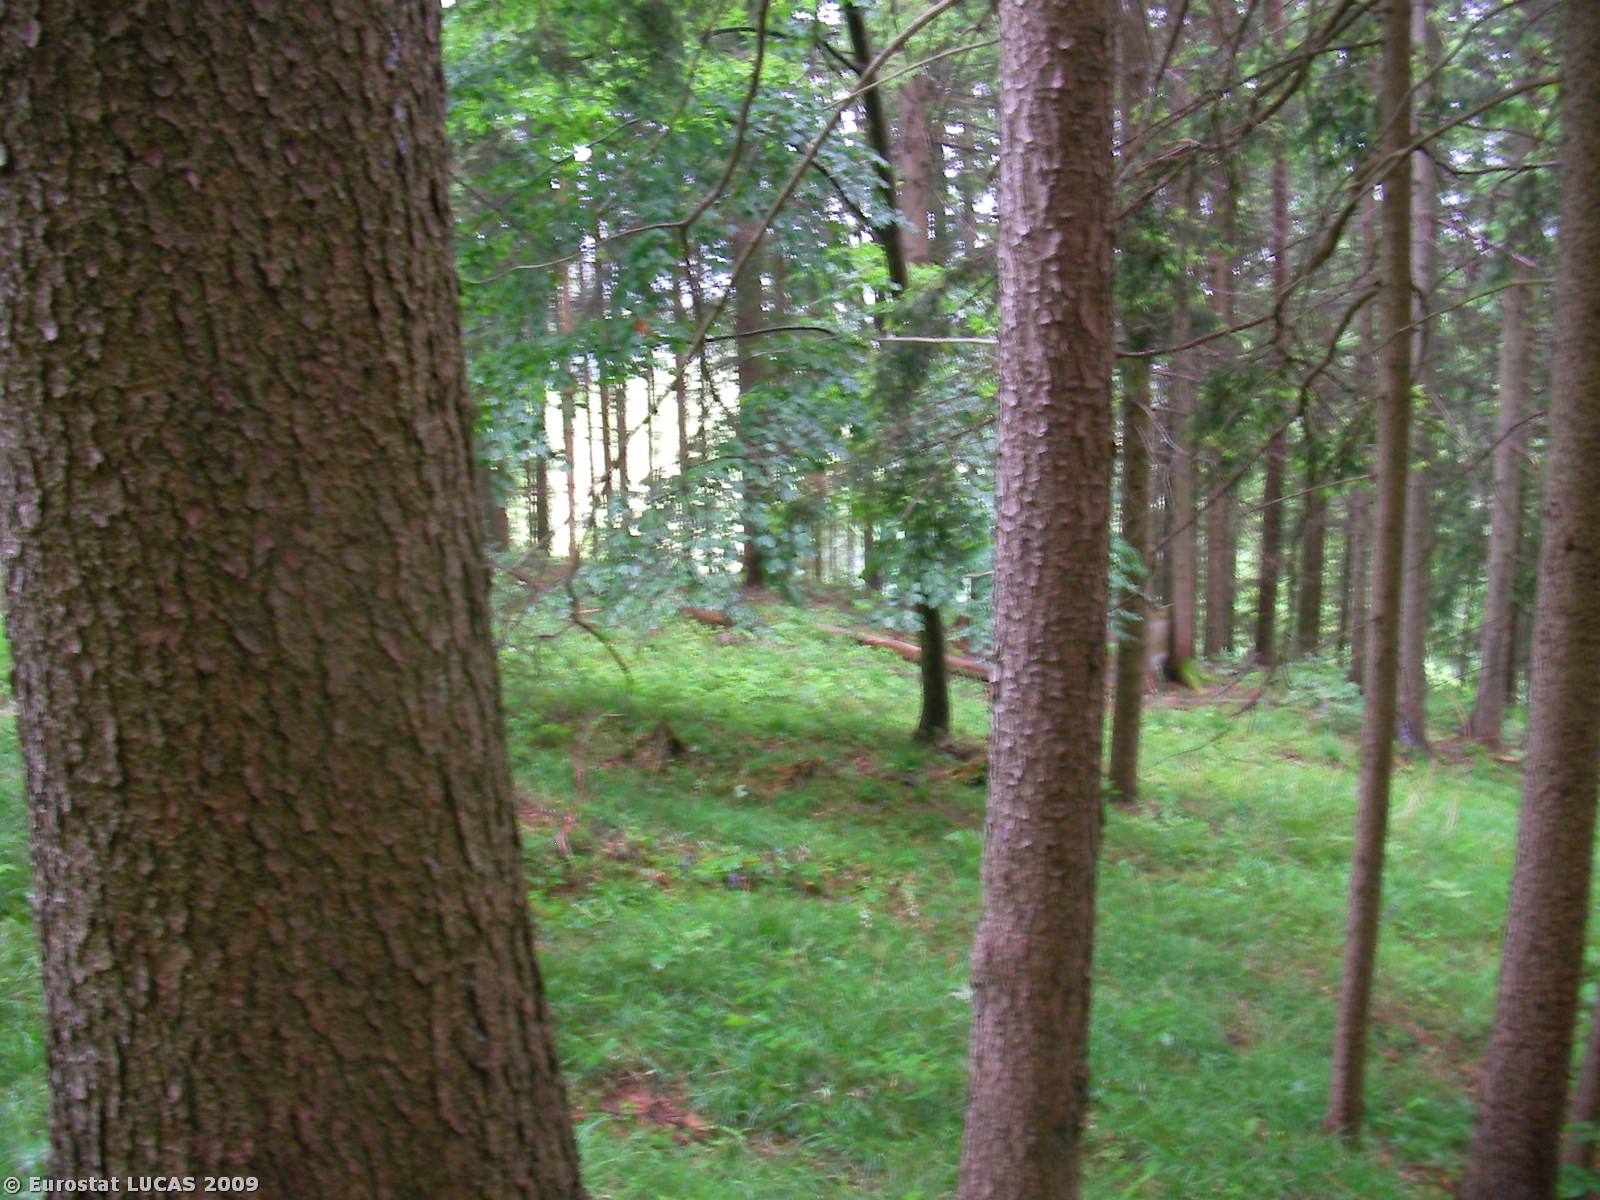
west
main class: Woodland
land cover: Coniferous woodland
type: alpine coniferous forest
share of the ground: > 75 %
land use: Forestry
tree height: > 5 m
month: May
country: AT
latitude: 47.2712
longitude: 15.5654
